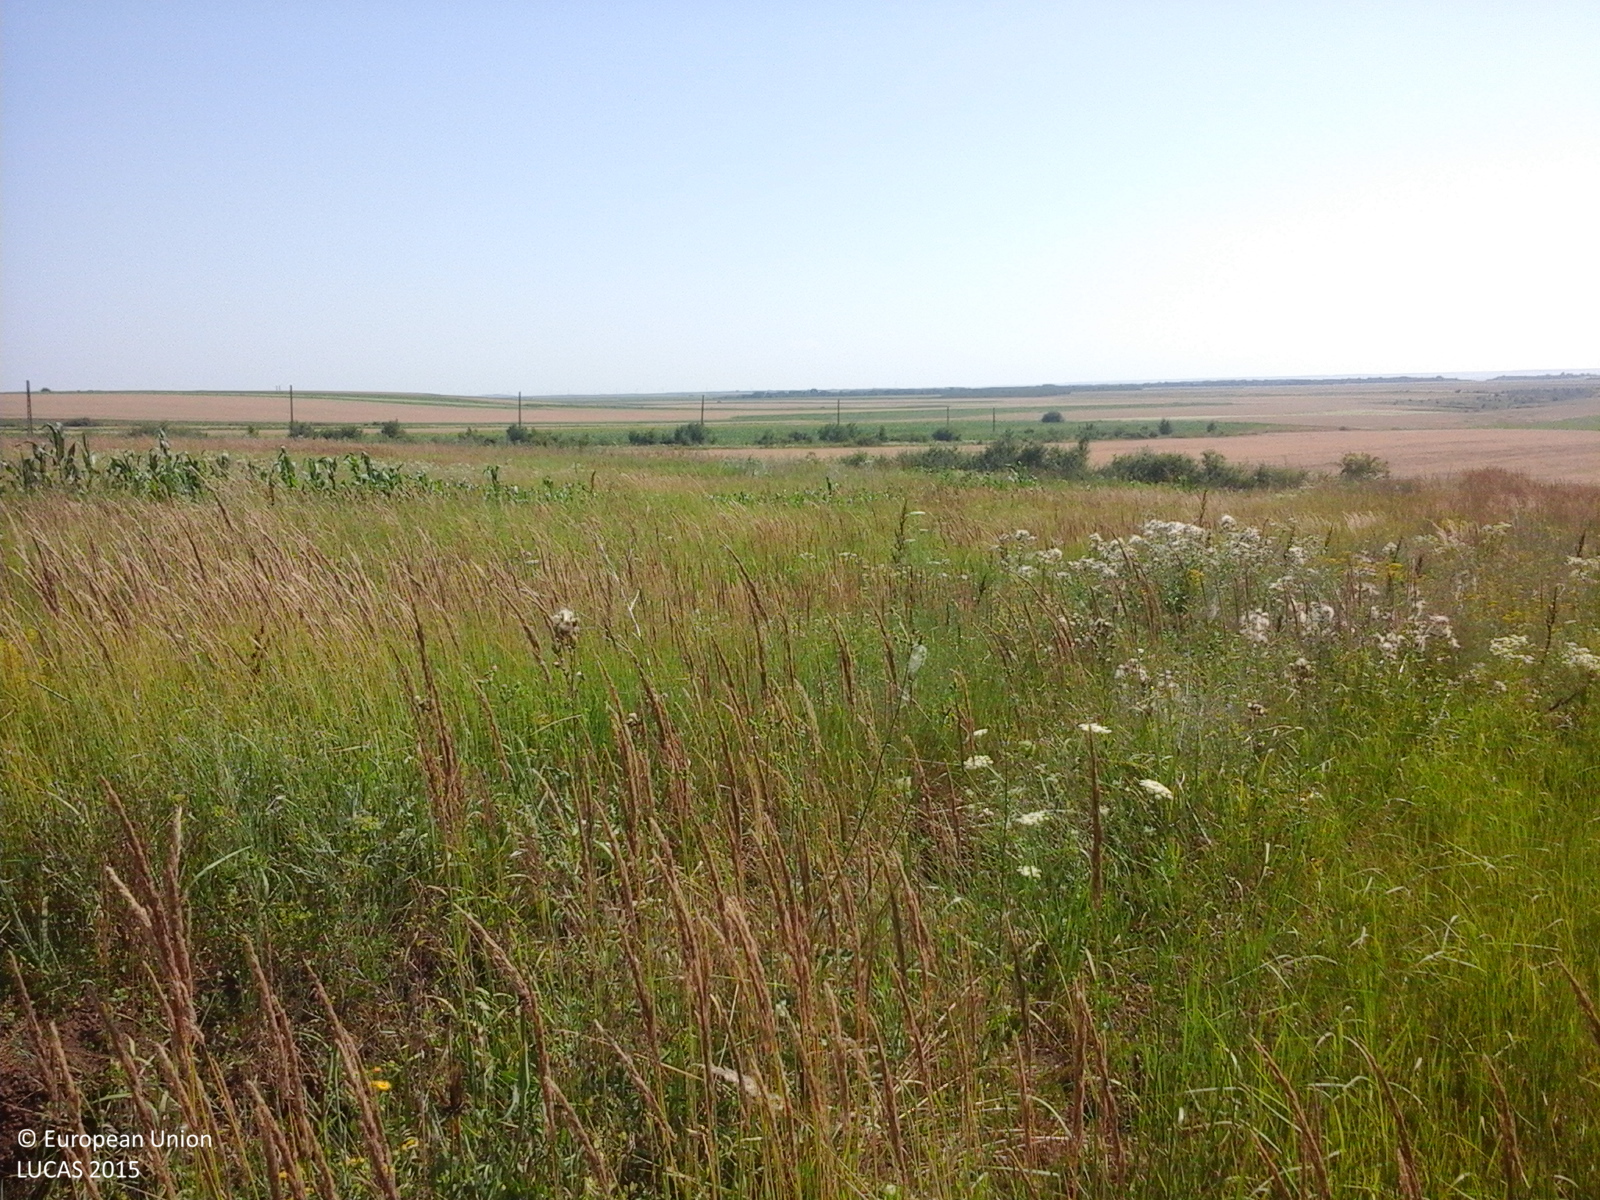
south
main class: Grassland
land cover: Grassland with sparse tree/shrub cover
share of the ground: > 75 %
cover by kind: herbaceous plants 85 %, shrubs 10 %, broadleaved forest trees 5 %
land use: Agriculture (excluding fallow land and kitchen gardens)
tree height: < 5 m
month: July
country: RO
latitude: 44.5678
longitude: 24.3861
